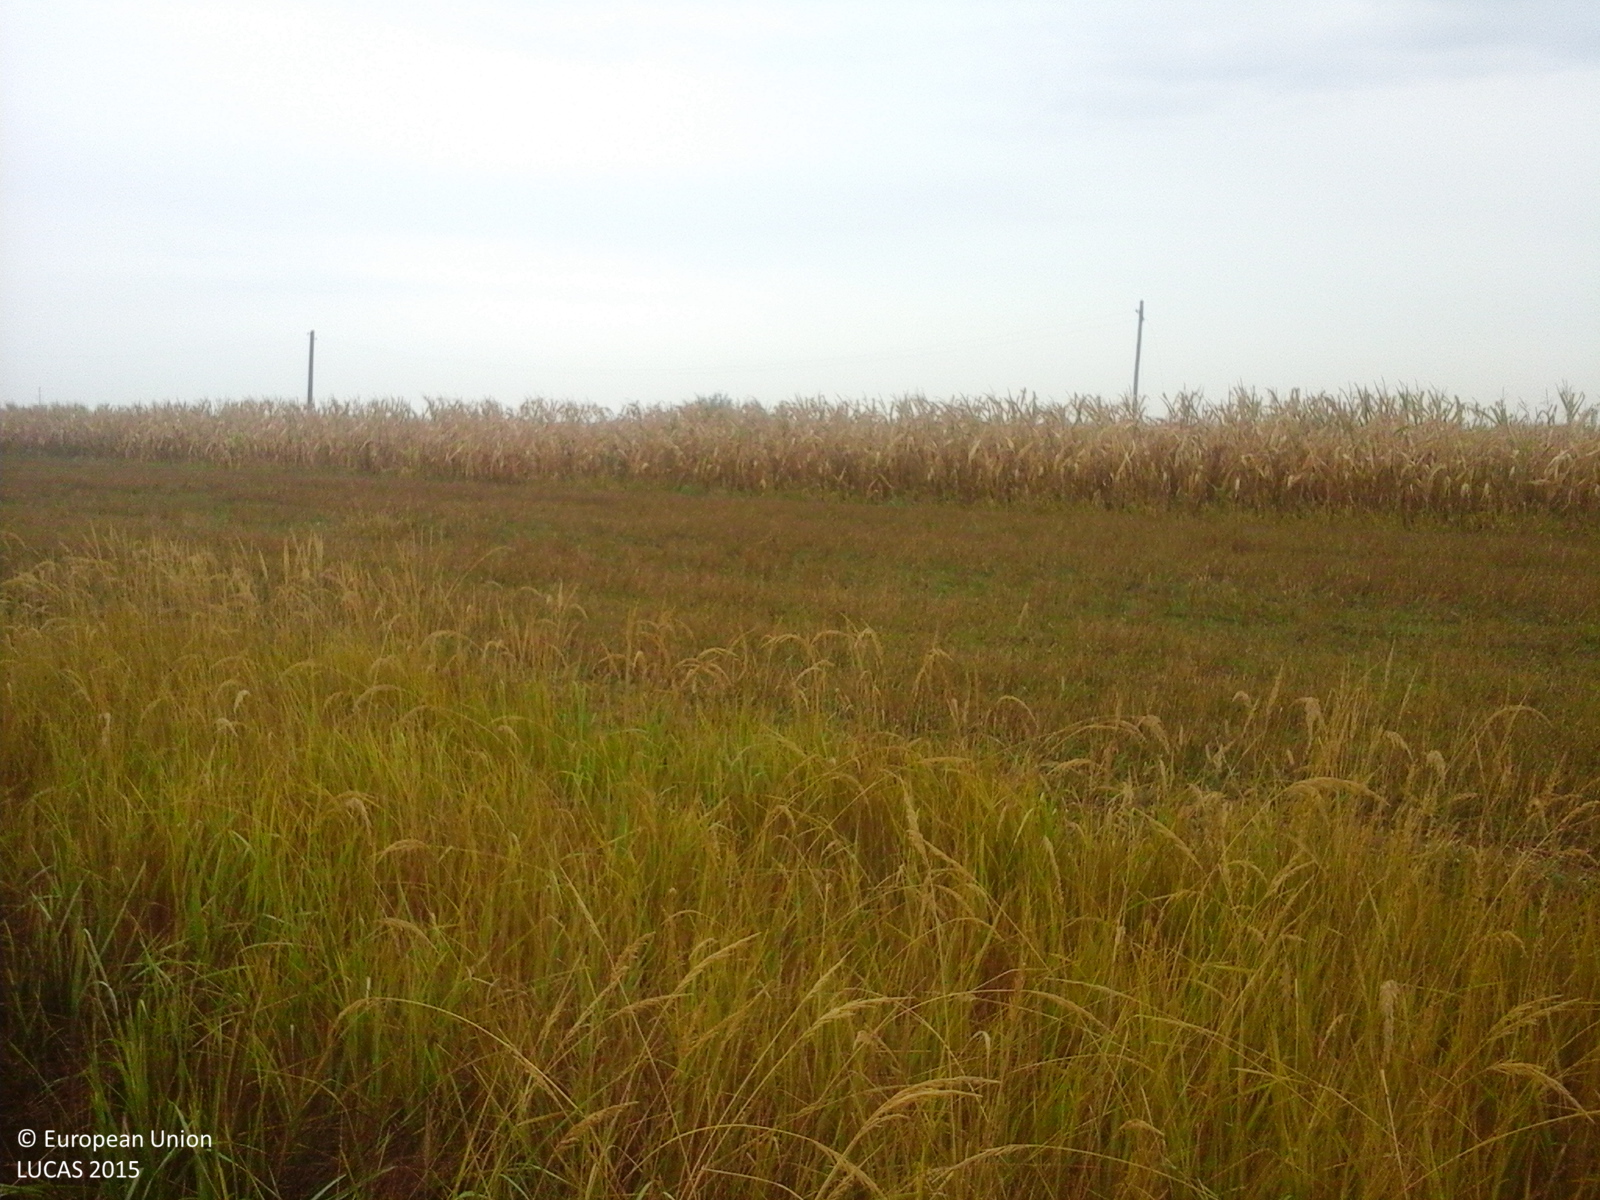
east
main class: Grassland
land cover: Spontaneously vegetated surfaces
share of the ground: > 75 %
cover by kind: herbaceous plants 100 %
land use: Fallow land
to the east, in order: Spontaneously vegetated surfaces; Common wheat; Maize; Spontaneously vegetated surfaces; Electric lines; Ditches and canals; Grass margins; Paved roads, cycling and walking lanes; Grass margins; Ditches and canals; Spontaneously vegetated surfaces; Maize
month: September
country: RO
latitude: 47.5737
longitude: 22.5679
